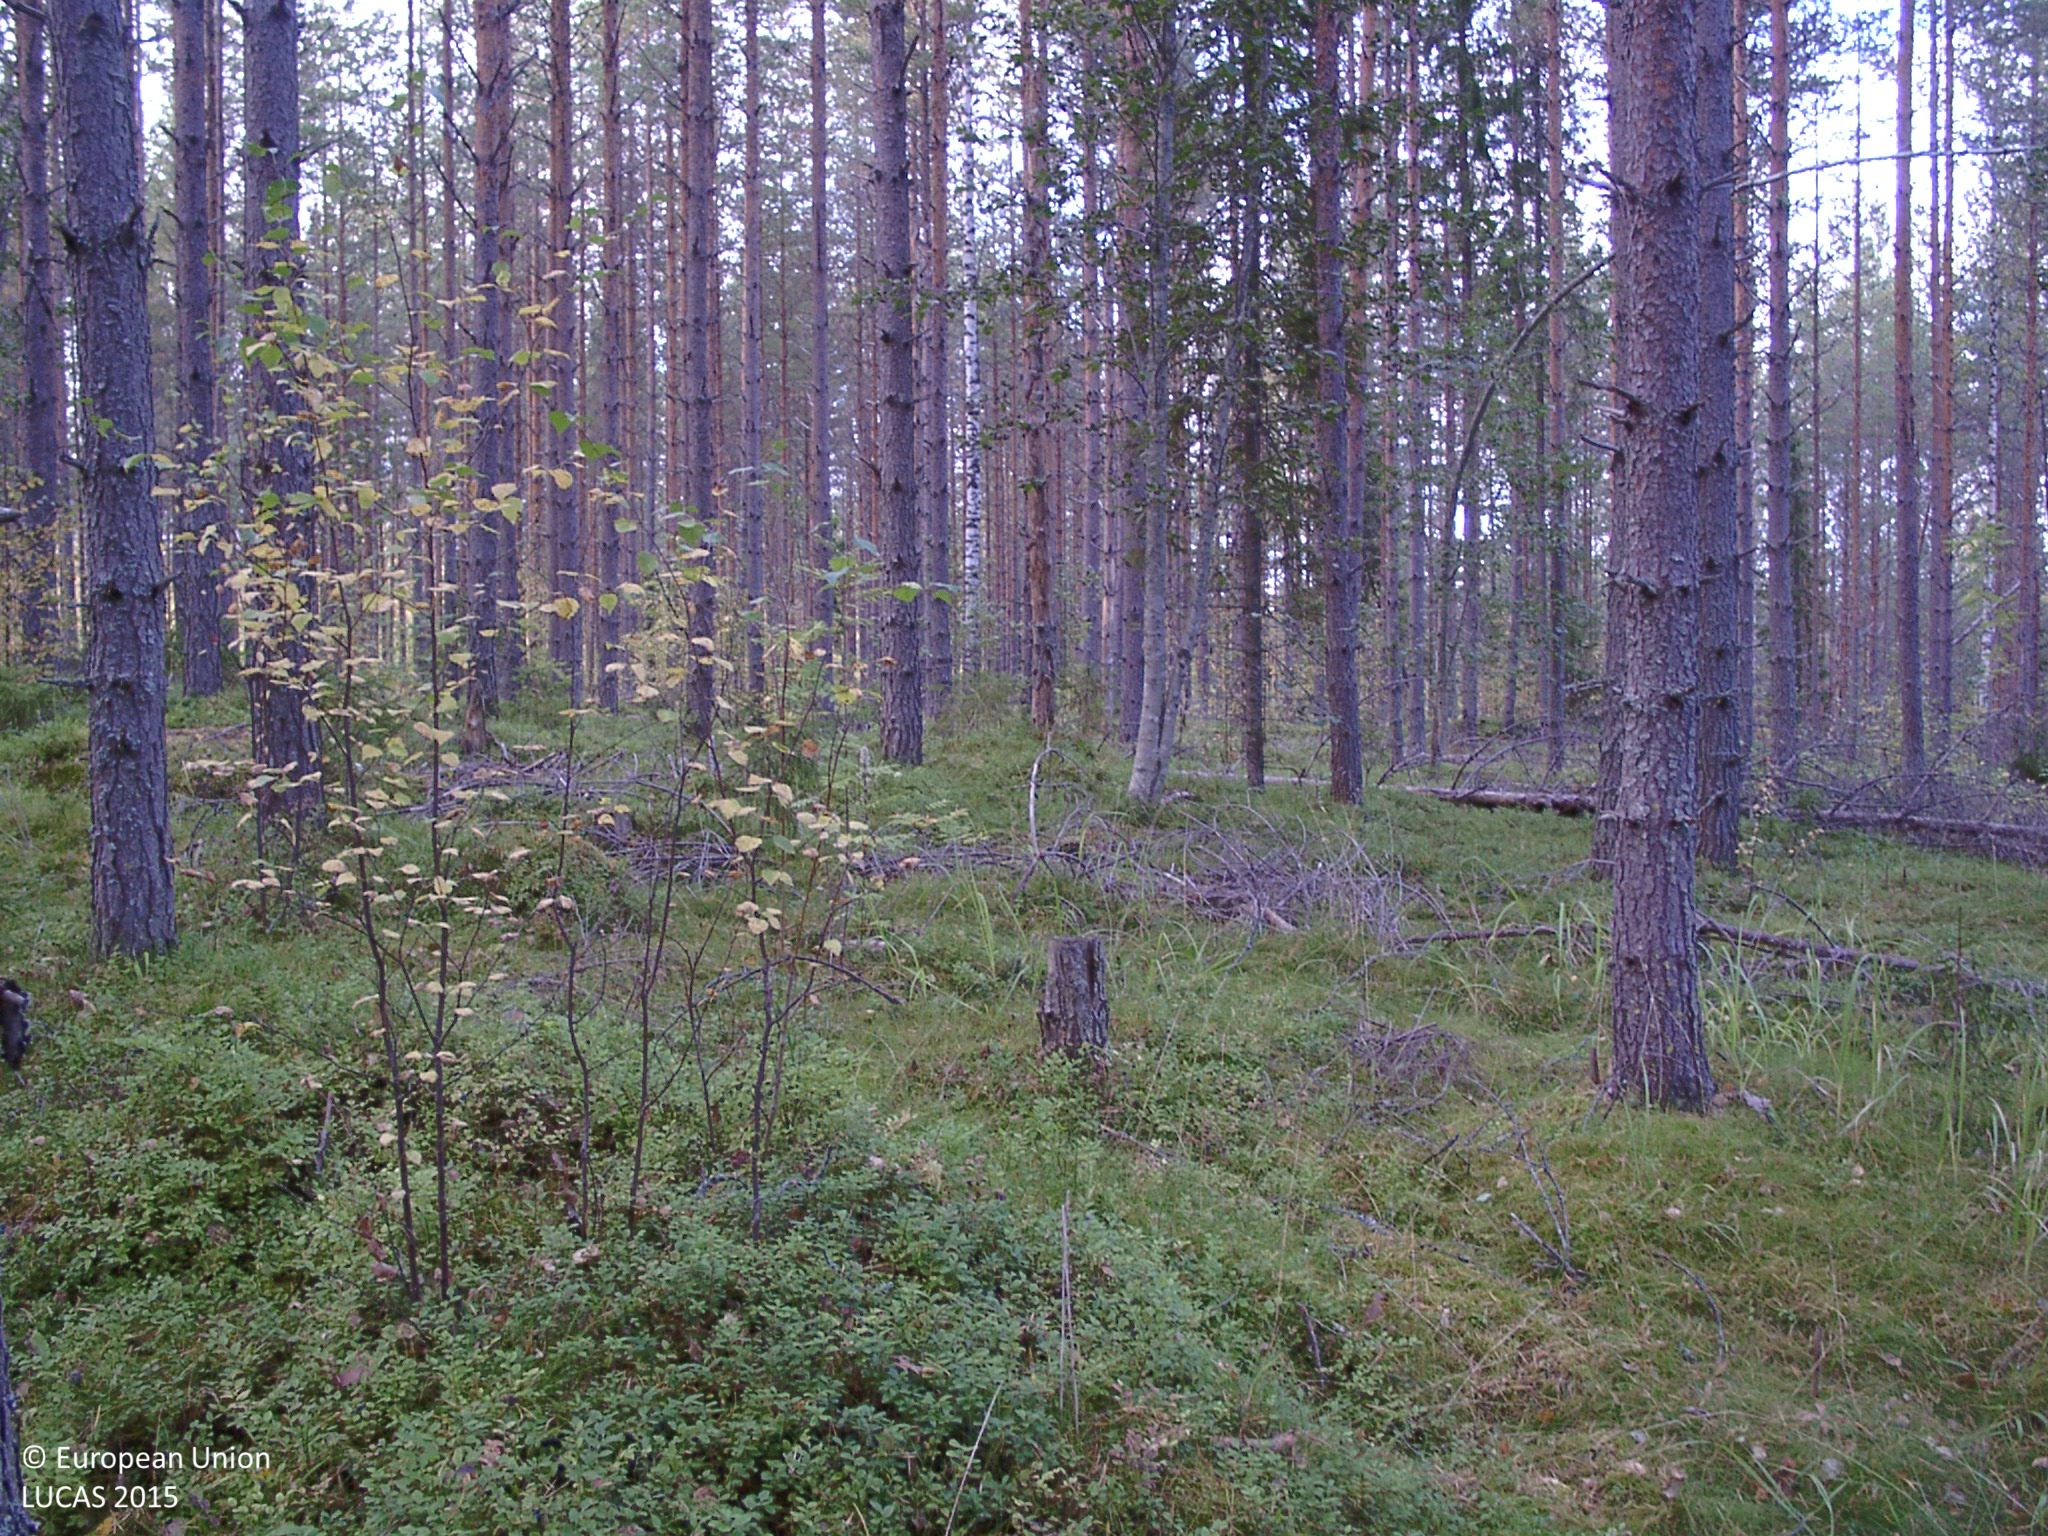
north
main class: Woodland
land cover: Pine dominated coniferous woodland
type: boreal forest
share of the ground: > 75 %
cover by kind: coniferous forest trees 75 %, shrubs 10 %, herbaceous plants 10 %, lichens and mosses 5 %
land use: Forestry
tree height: > 5 m
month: September
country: FI
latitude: 62.5629
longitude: 25.1006
